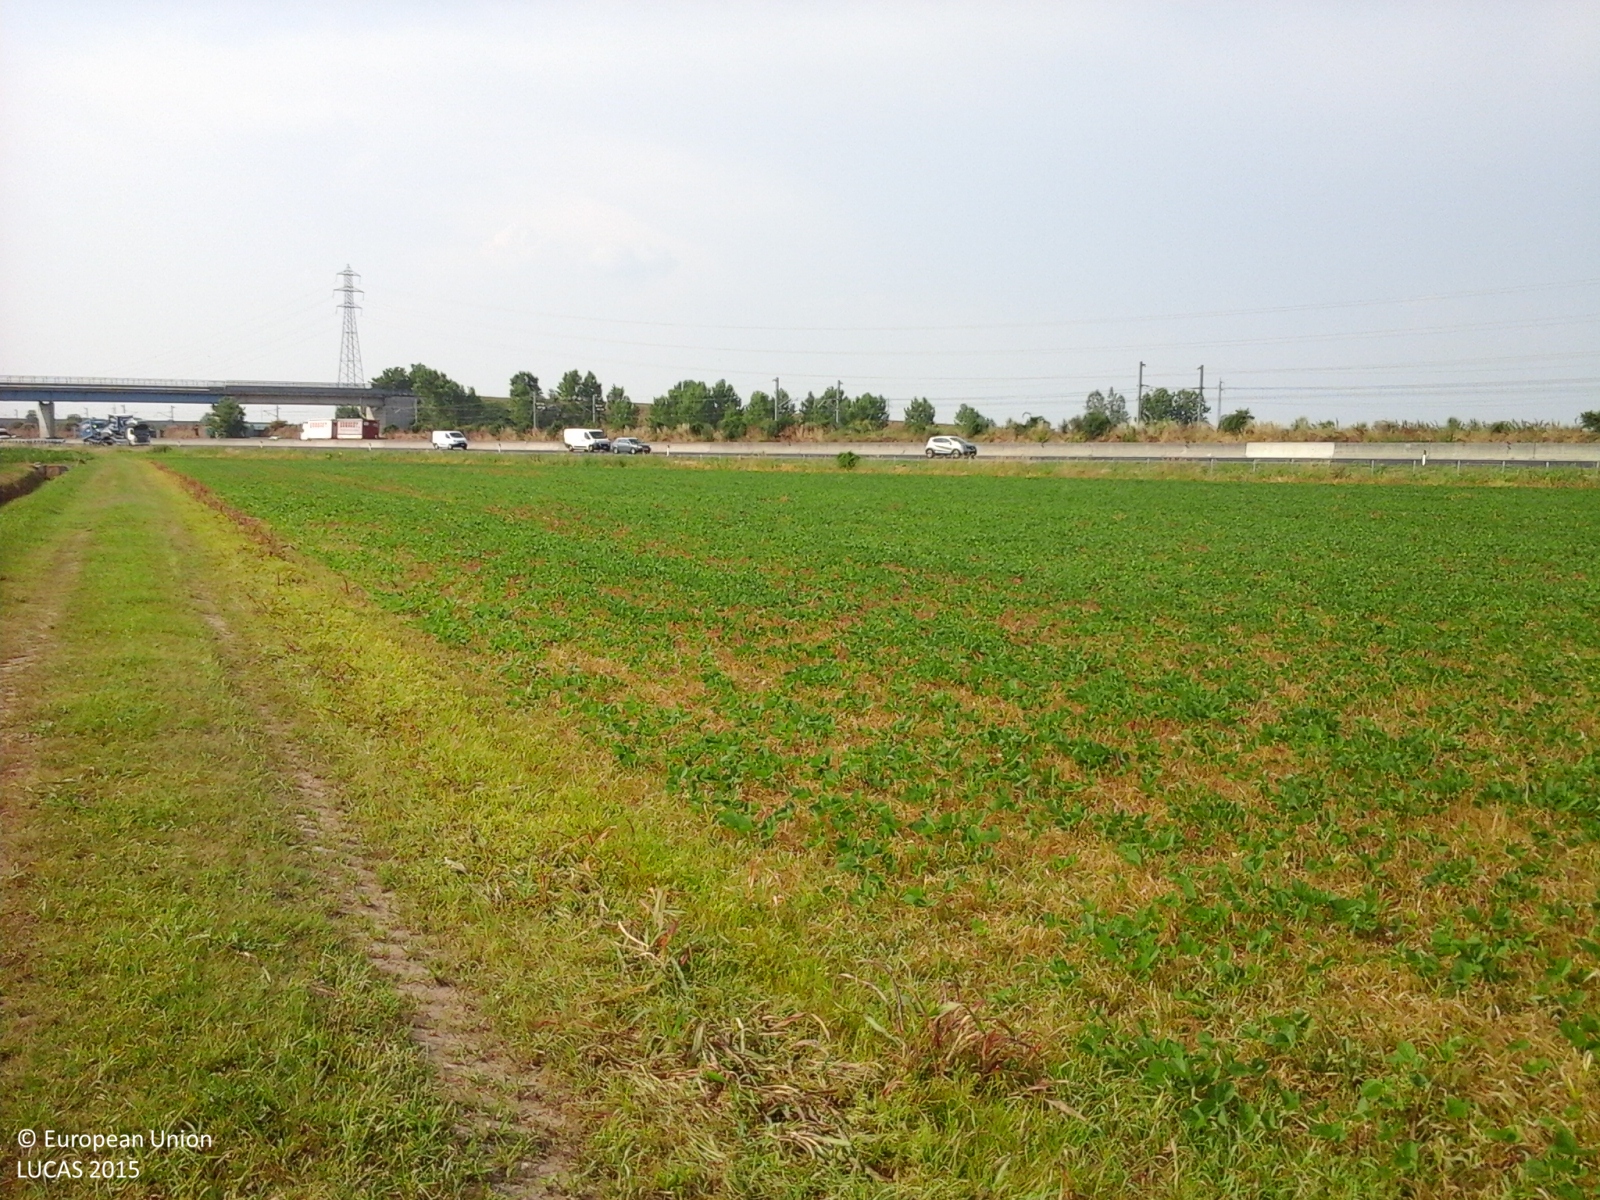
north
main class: Artificial land
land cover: Non built-up linear features
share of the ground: > 75 %
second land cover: Grassland without tree/shrub cover
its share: > 75 %
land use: Road transport
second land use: Agriculture (excluding fallow land and kitchen gardens)
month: June
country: IT
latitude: 45.1612
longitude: 9.6064
